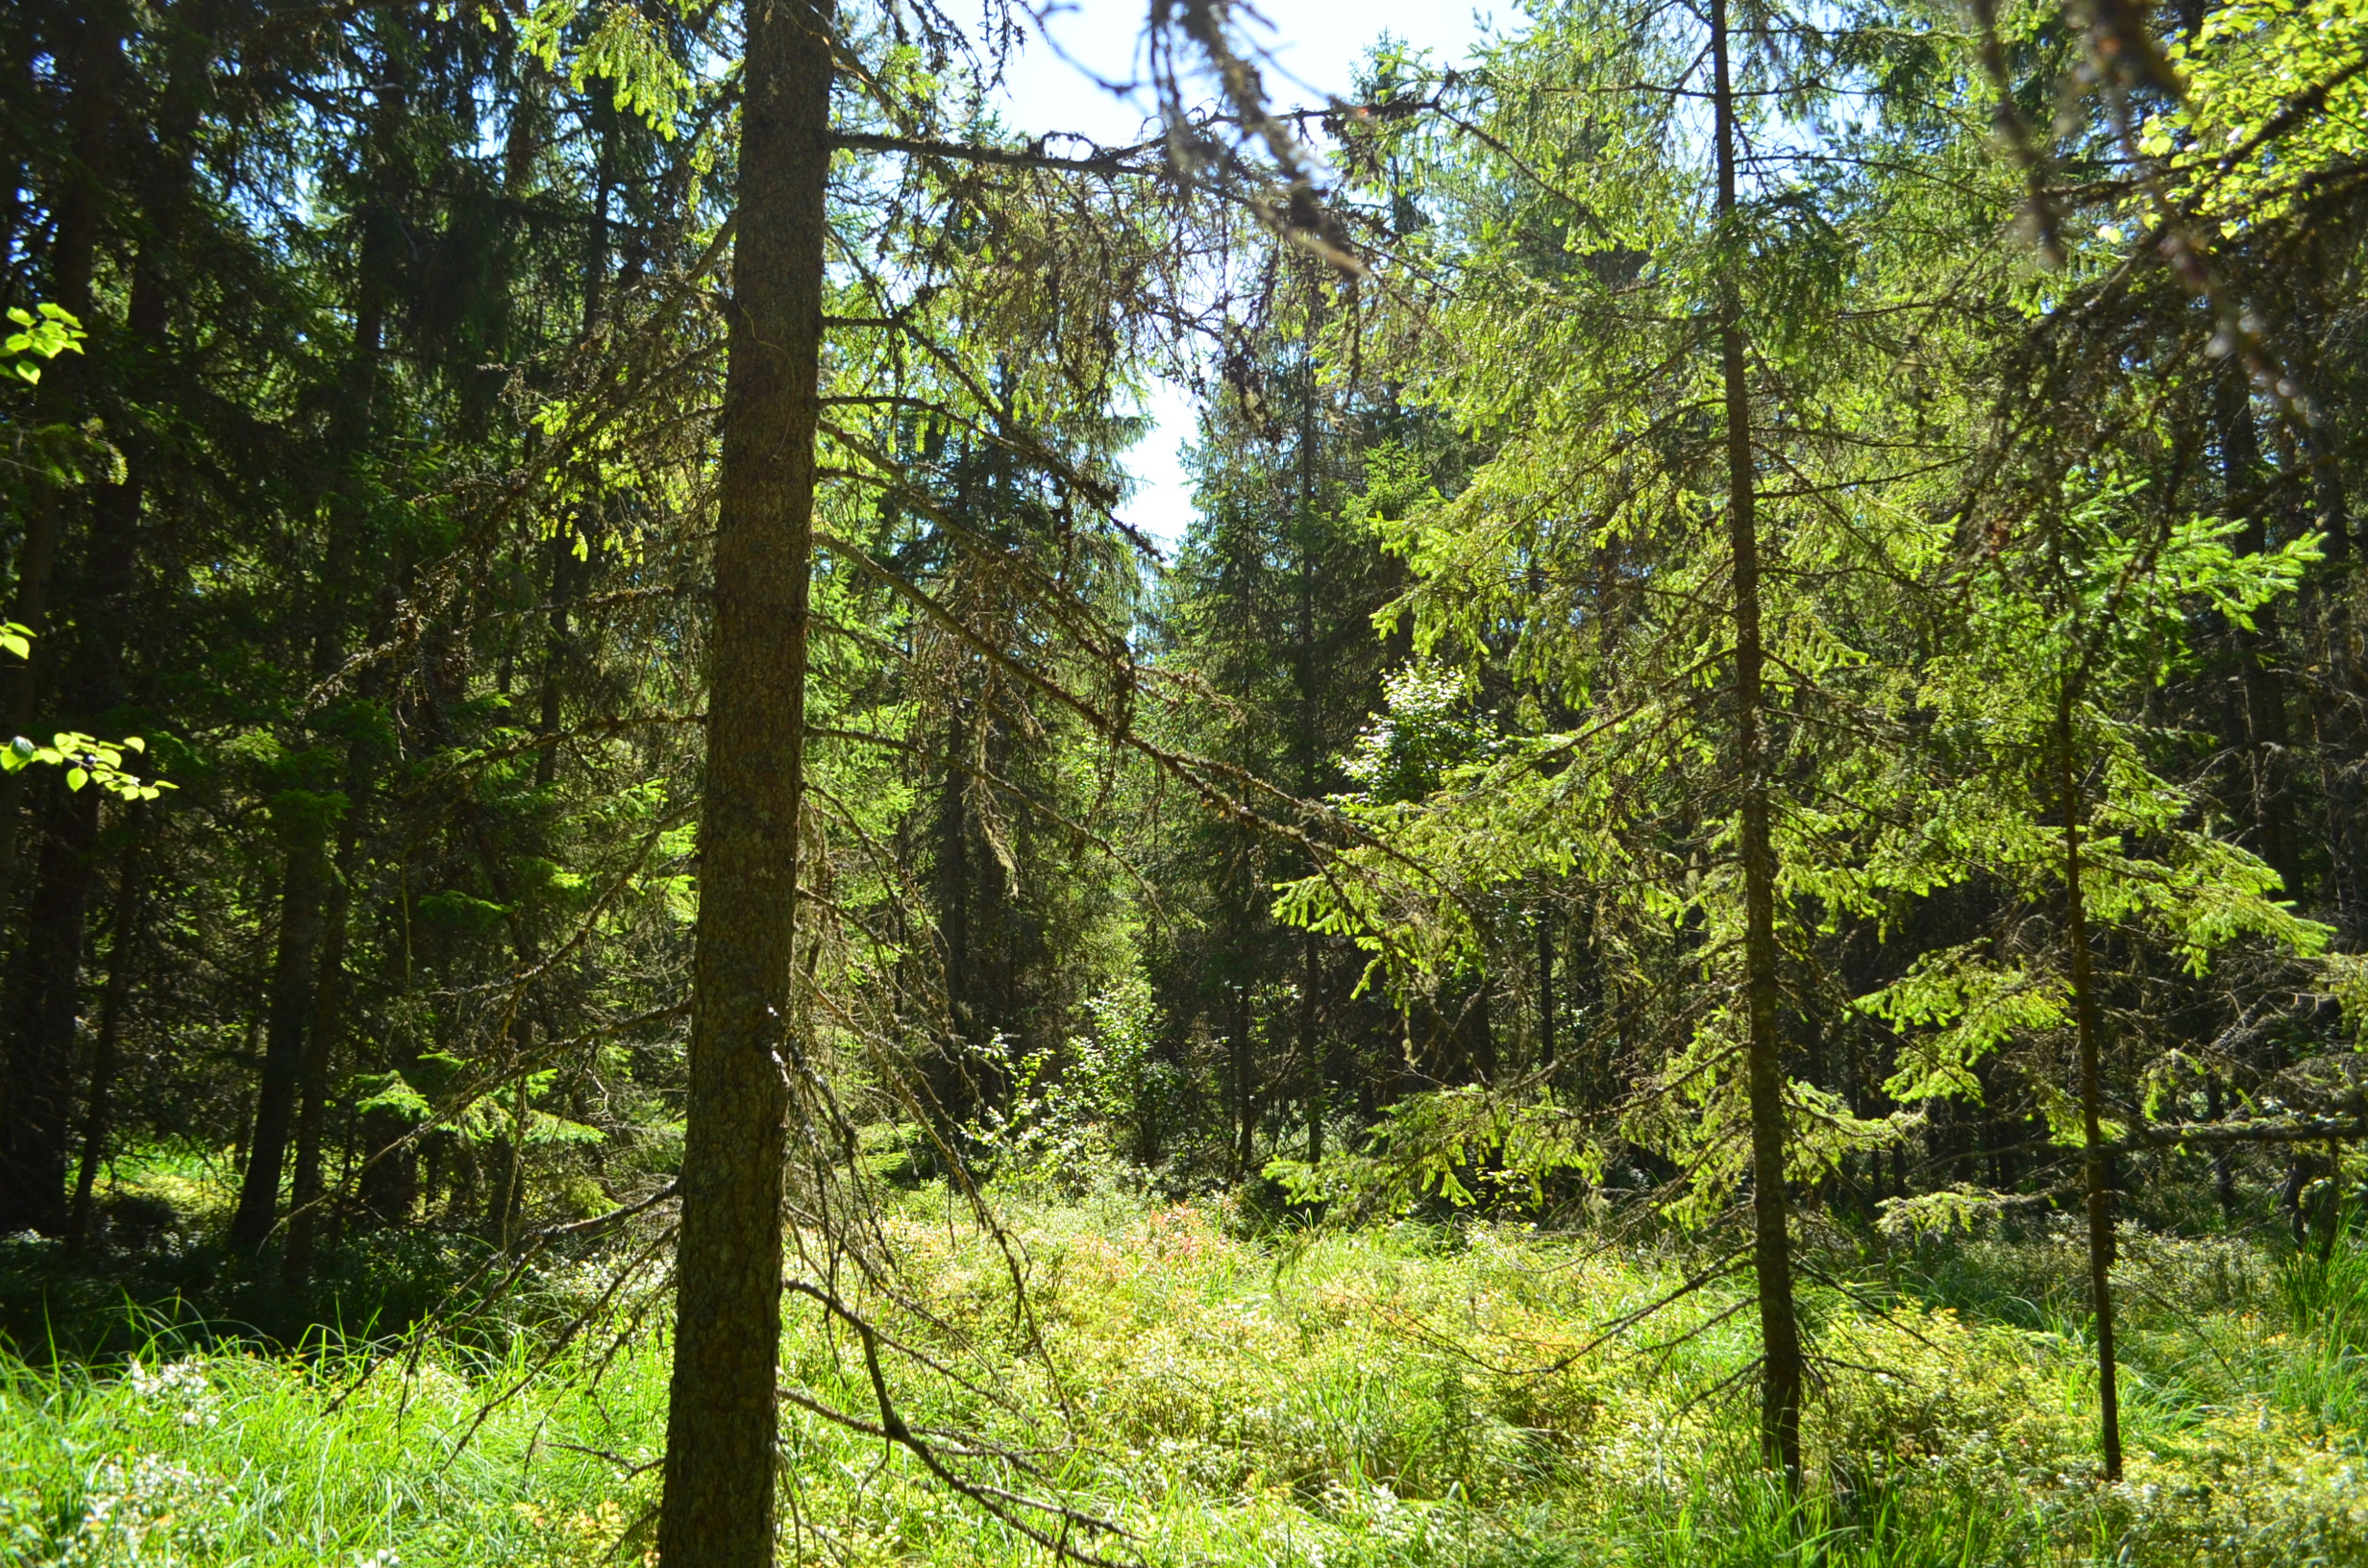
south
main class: Woodland
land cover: Other coniferous woodland
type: hemiboreal forest and nemoral coniferous forest and mixed broadleaved-coniferous forest
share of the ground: 50 - 75 %
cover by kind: coniferous forest trees 70 %, shrubs 10 %, herbaceous plants 10 %, broadleaved forest trees 5 %, lichens and mosses 5 %
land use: Forestry
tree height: > 5 m
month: August
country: LV
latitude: 57.5606
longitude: 22.3013
